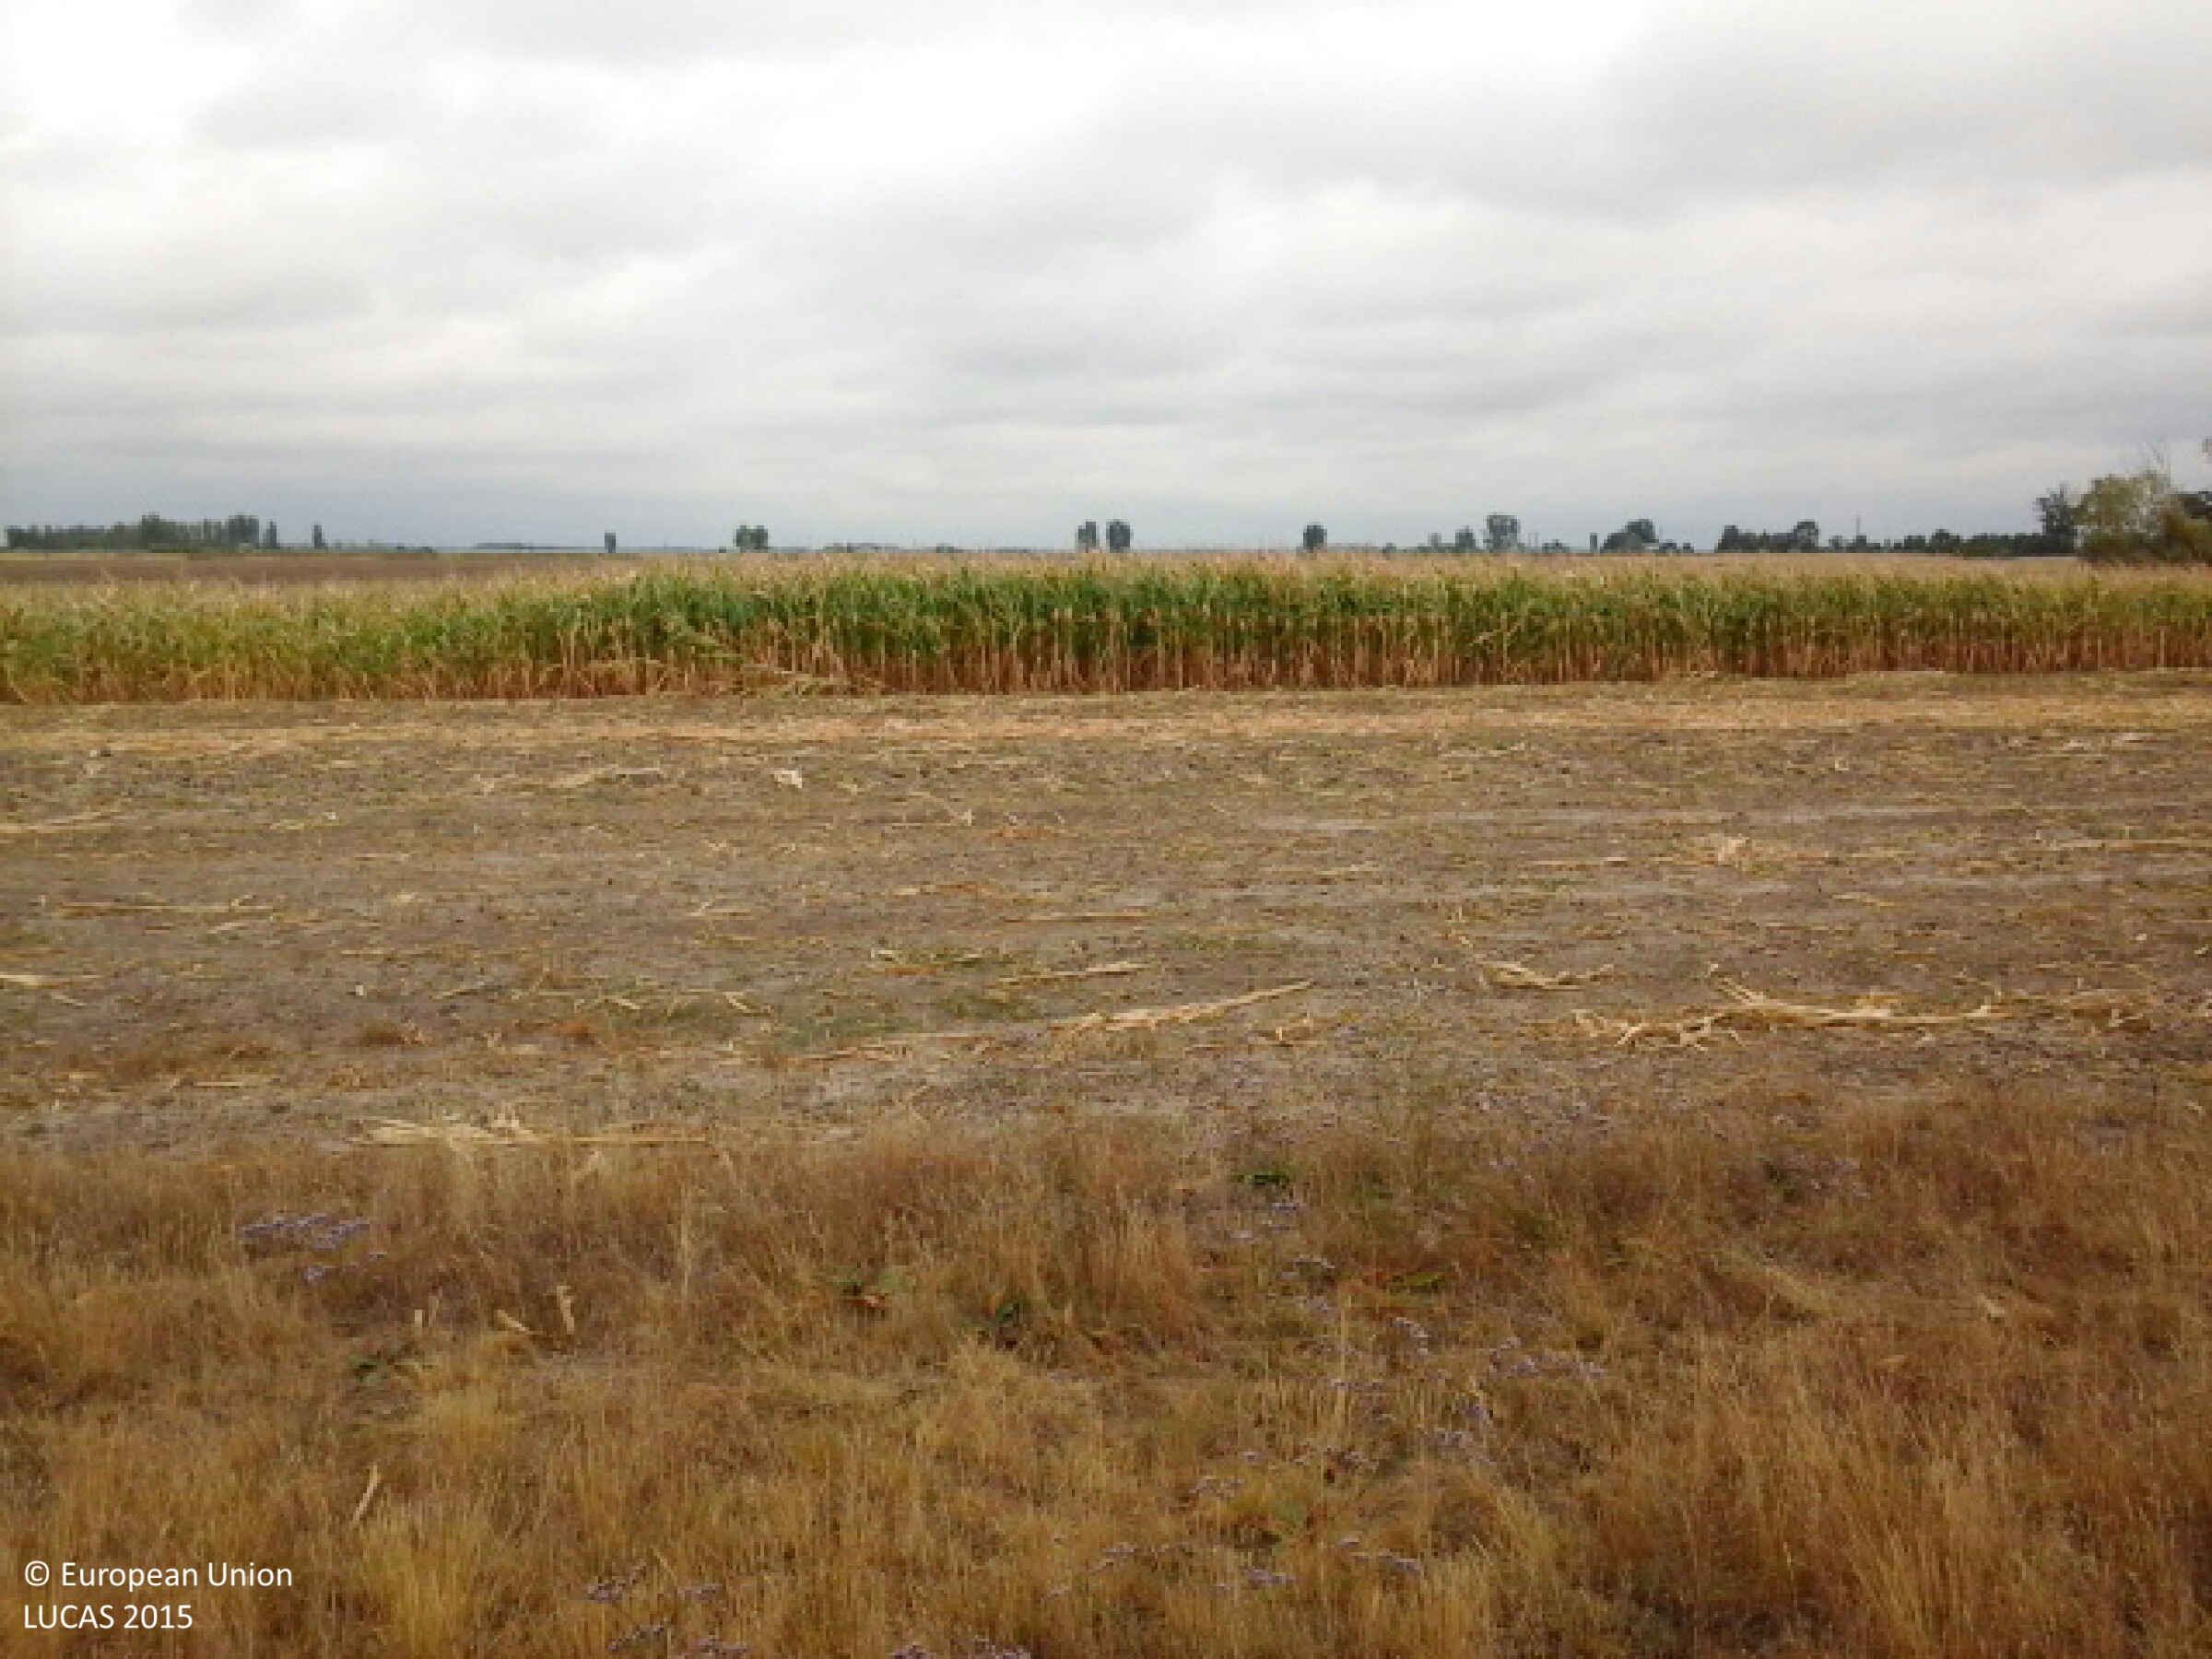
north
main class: Grassland
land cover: Grassland without tree/shrub cover
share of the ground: > 75 %
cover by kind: herbaceous plants 100 %
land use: Agriculture (excluding fallow land and kitchen gardens)
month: August
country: HU
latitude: 47.1412
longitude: 21.5530
